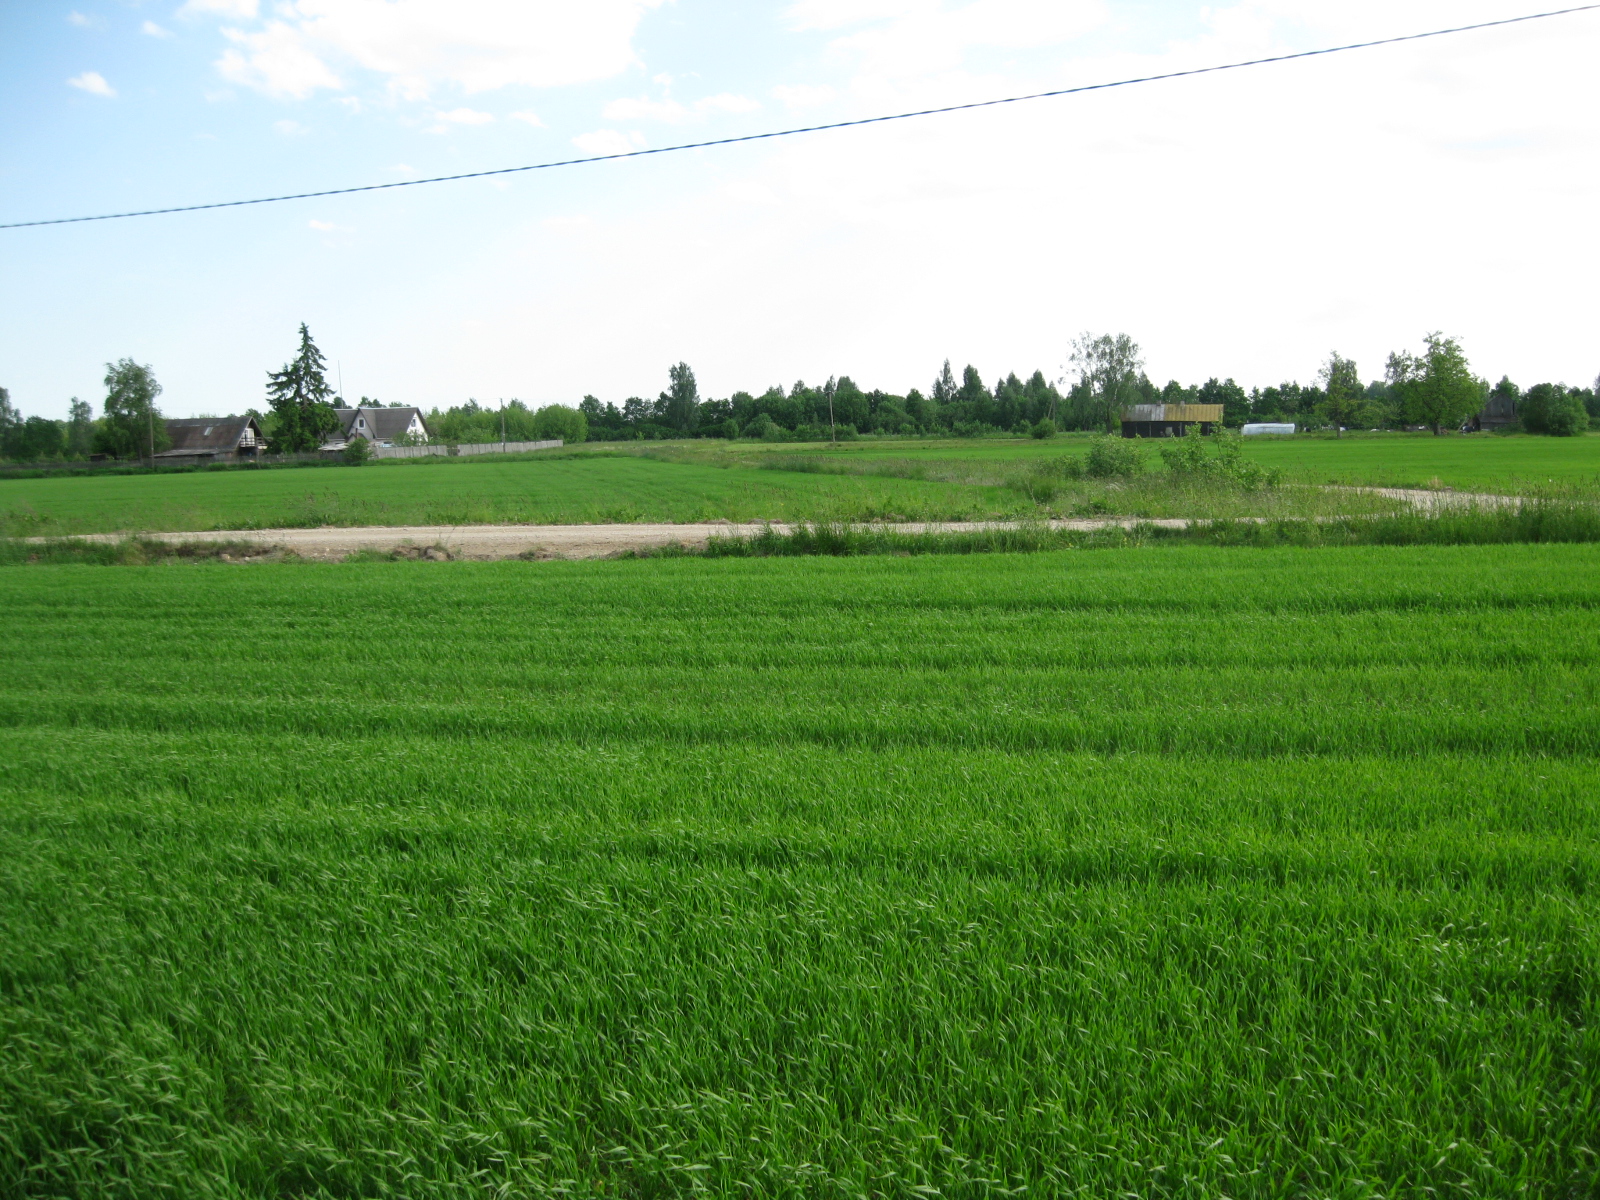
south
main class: Cropland
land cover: Dry pulses
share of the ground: 50 - 75 %
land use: Agriculture (excluding fallow land and kitchen gardens)
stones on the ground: < 10 %
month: June
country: LT
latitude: 55.7517
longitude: 24.0950
